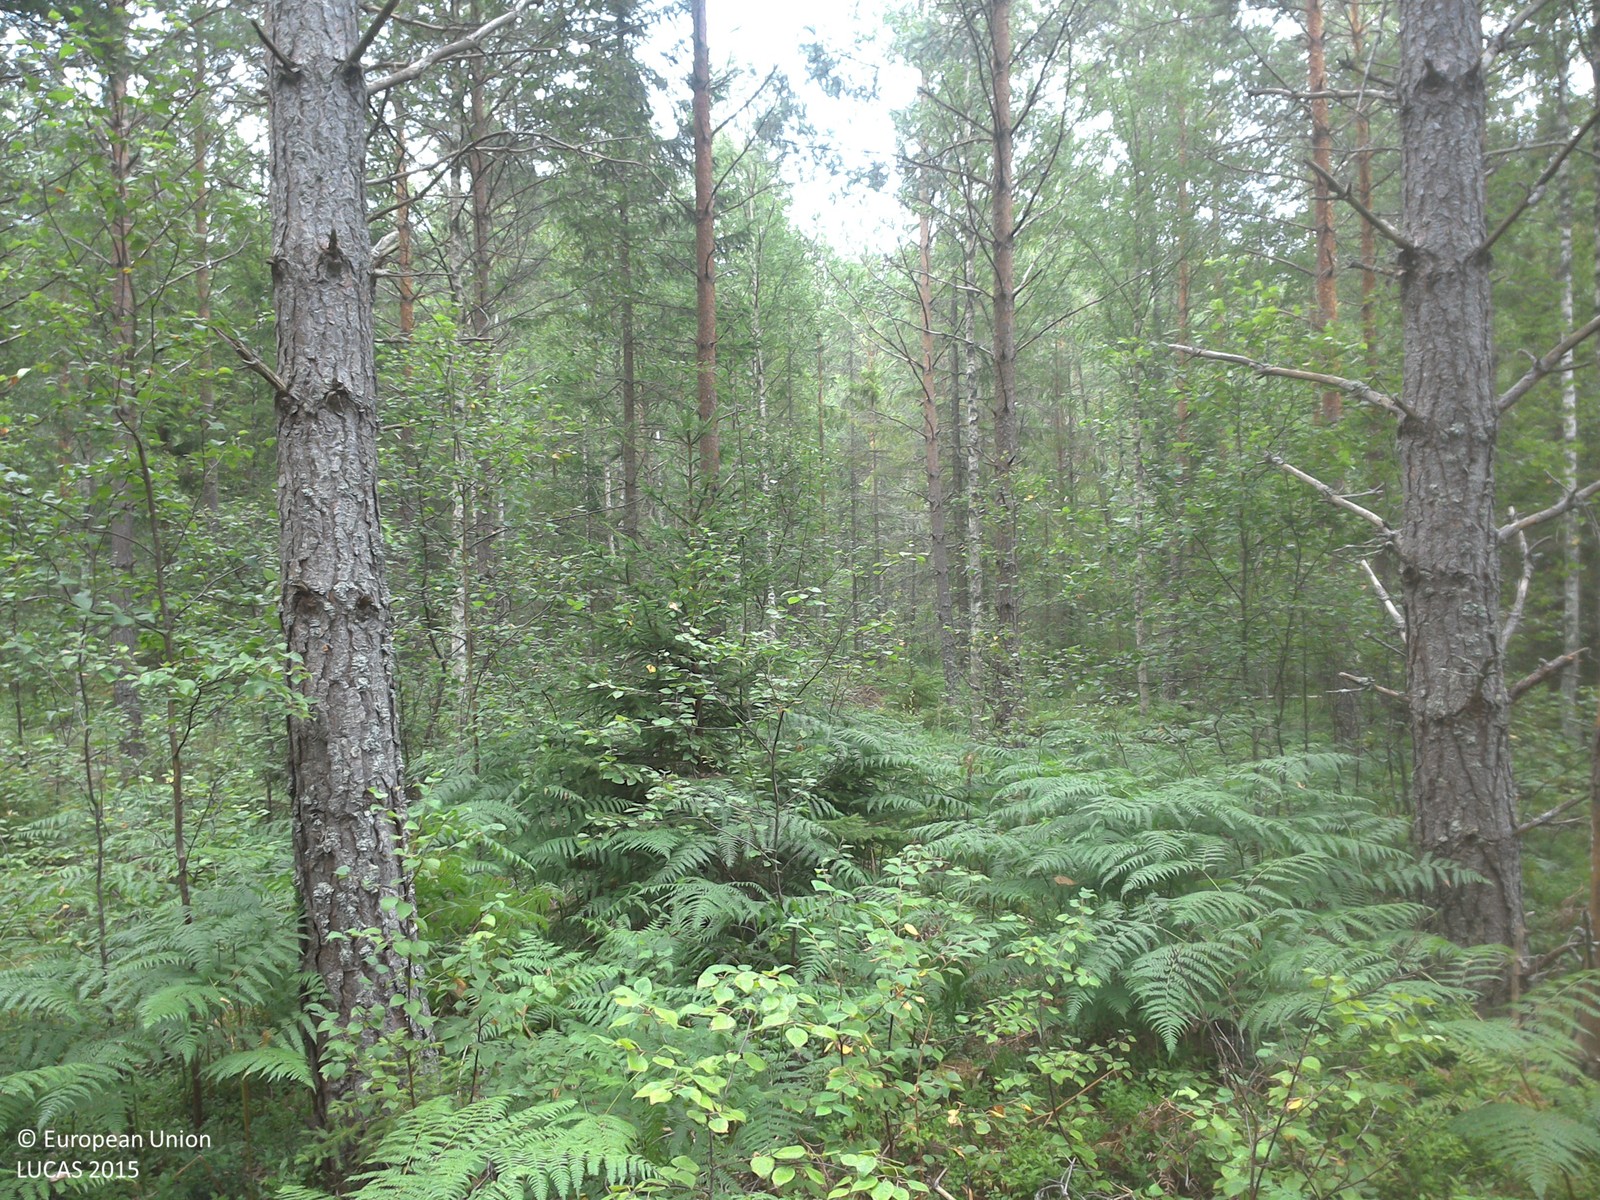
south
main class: Woodland
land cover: Pine dominated coniferous woodland
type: boreal forest
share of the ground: 25 - 50 %
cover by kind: herbaceous plants 50 %, coniferous forest trees 35 %, lichens and mosses 15 %
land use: Forestry
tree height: > 5 m
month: August
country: SE
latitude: 57.8253
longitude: 15.3332
